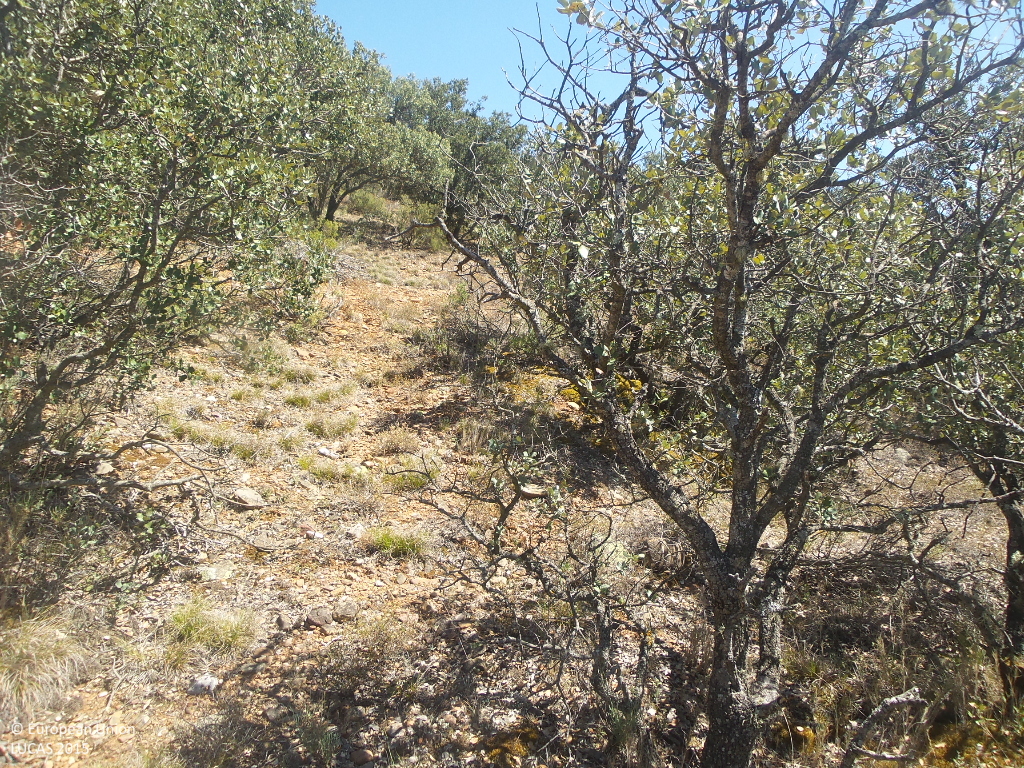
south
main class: Woodland
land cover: Broadleaved woodland
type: broadleaved evergreen forest
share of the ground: 50 - 75 %
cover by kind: broadleaved forest trees 70 %, shrubs 10 %, unconsolidated bare surface 10 %, herbaceous plants 5 %, lichens and mosses 5 %
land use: Semi-natural and natural areas not in use
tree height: < 5 m
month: July
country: ES
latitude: 41.3641
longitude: -2.0677
